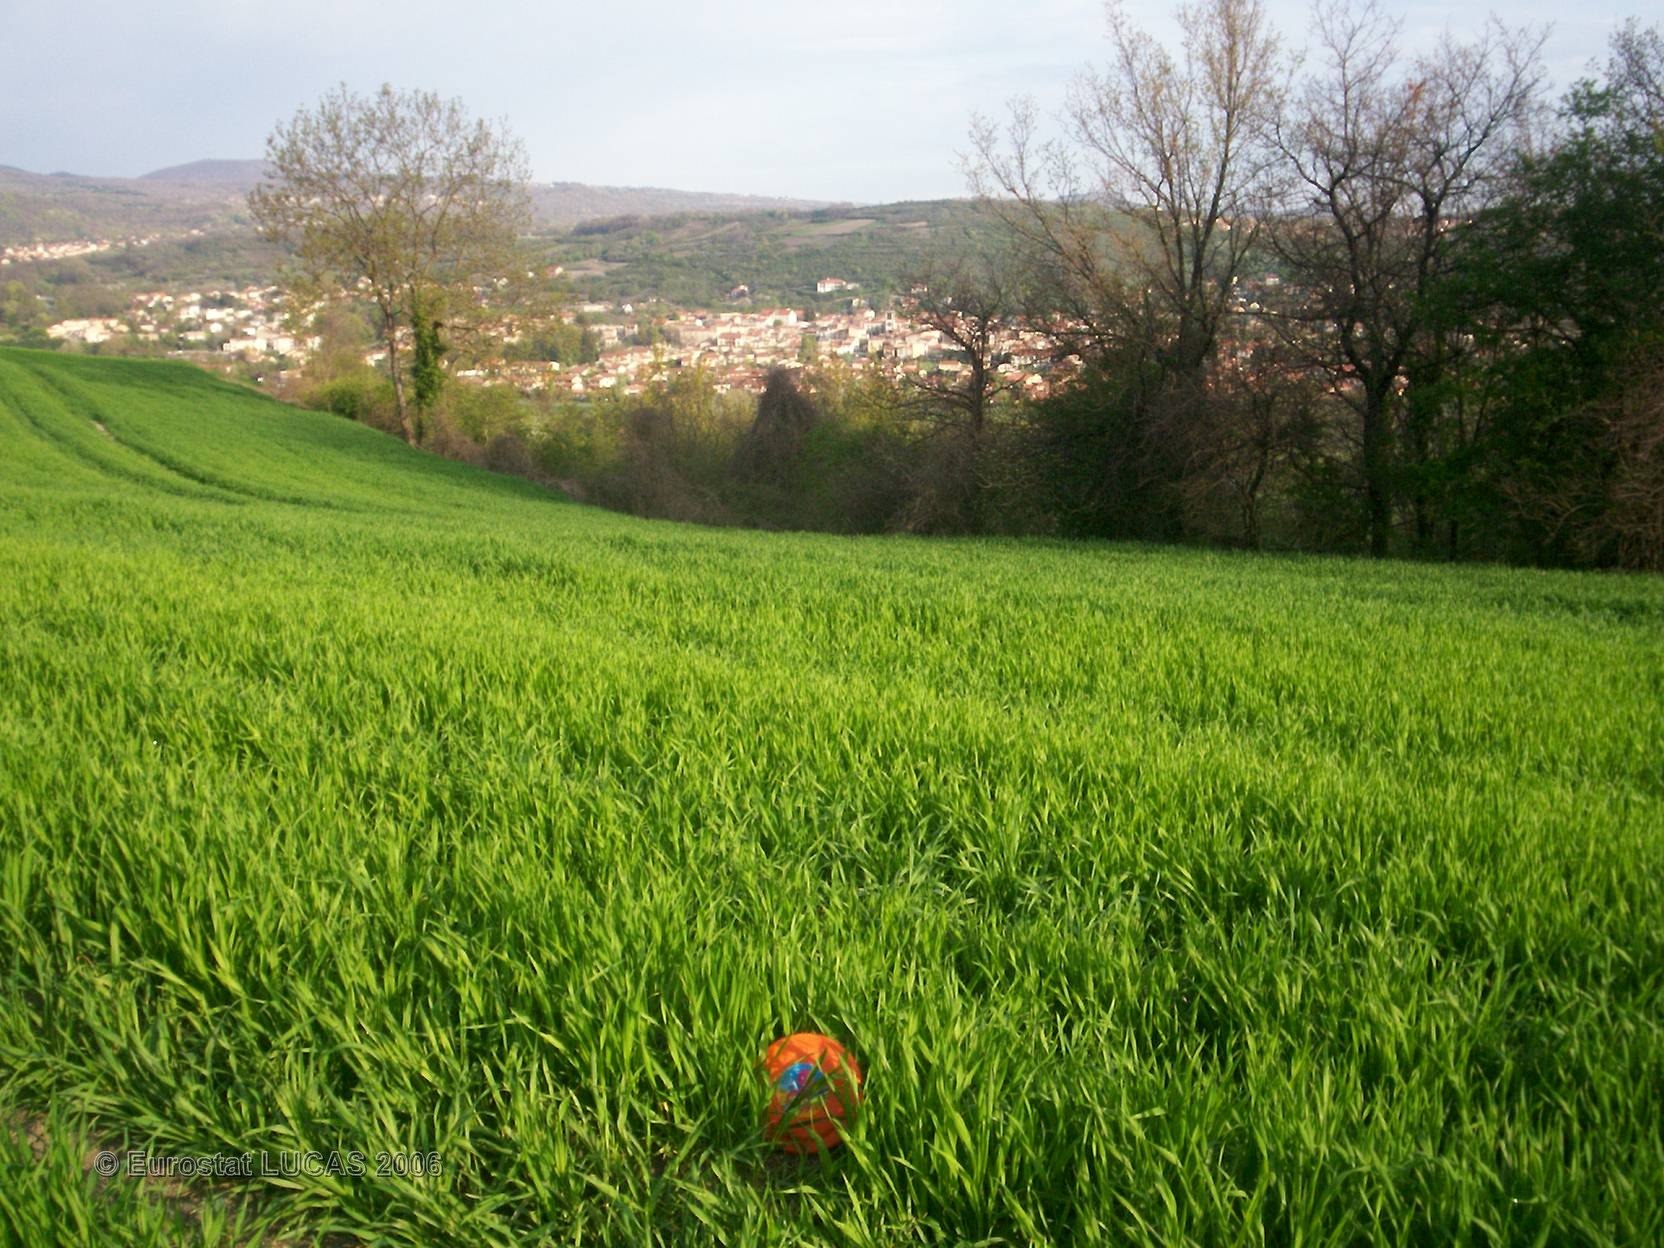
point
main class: Cropland
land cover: Common wheat
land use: Agriculture (excluding fallow land and kitchen gardens)
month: April
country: FR
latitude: 45.8202
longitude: 3.0879
